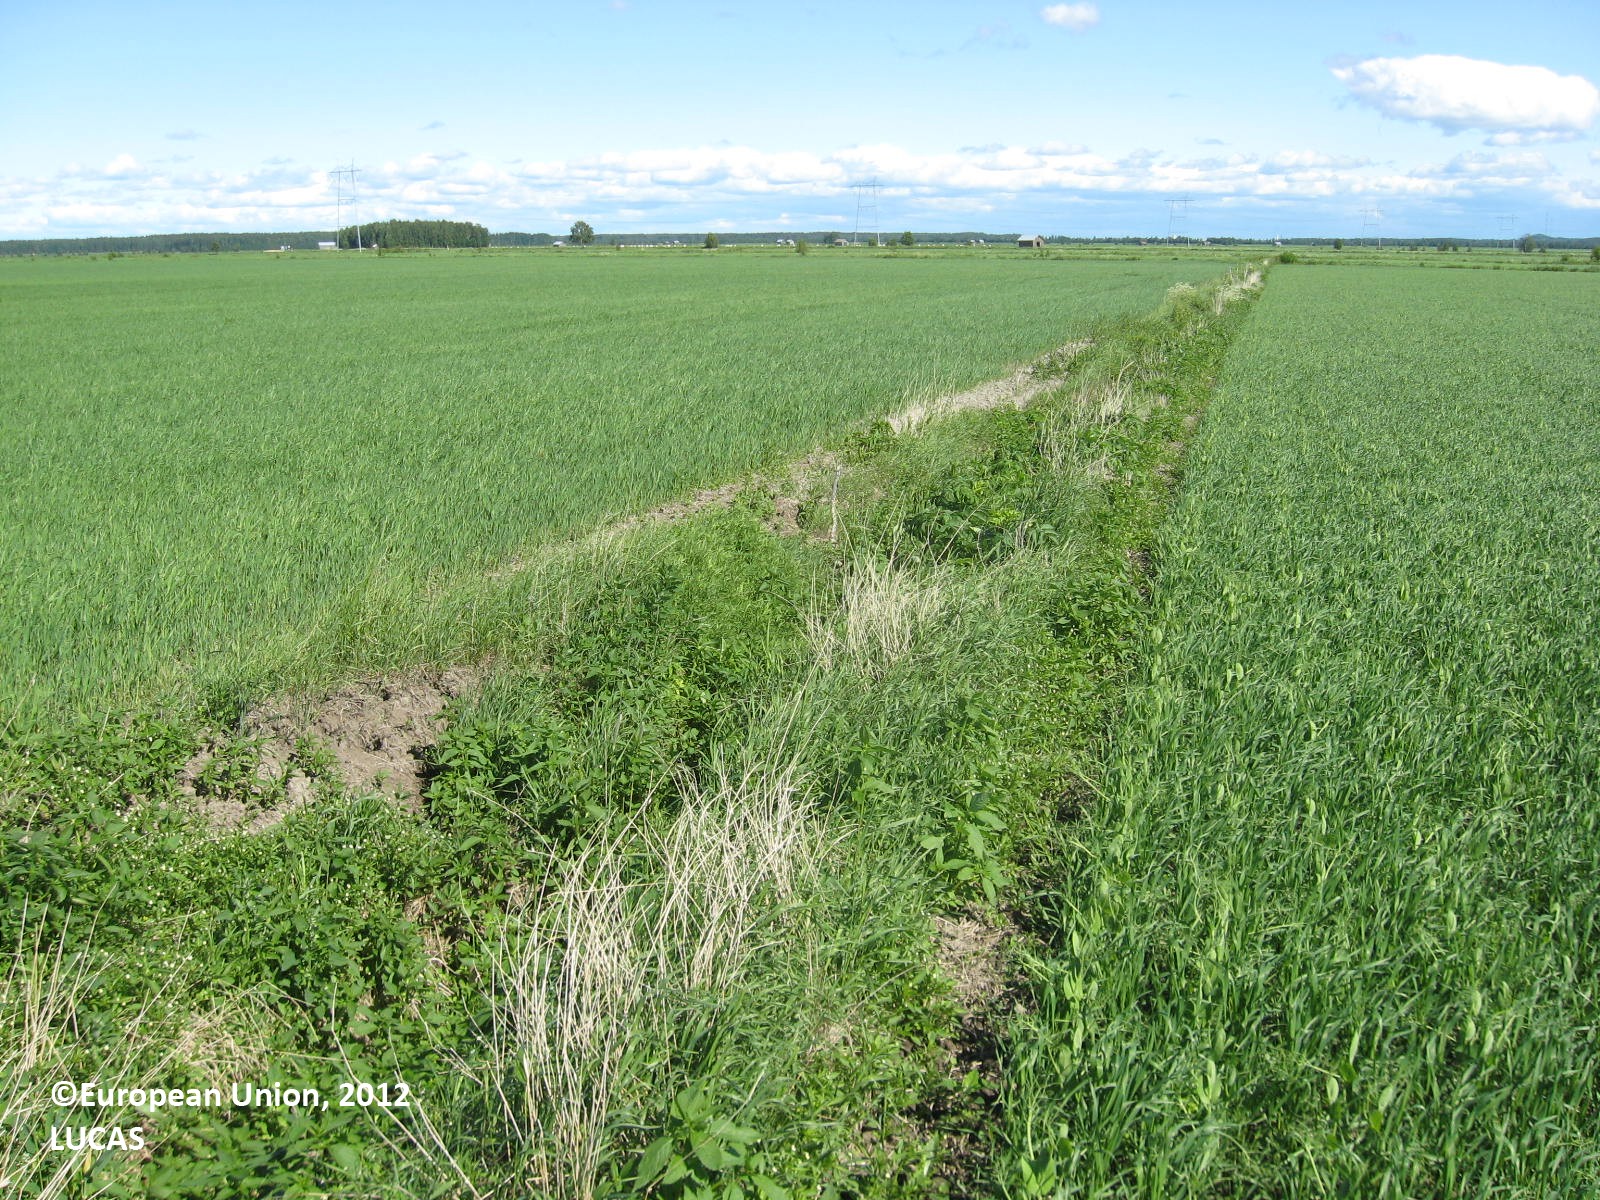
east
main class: Cropland
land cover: Temporary grasslands
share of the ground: > 75 %
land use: Agriculture (excluding fallow land and kitchen gardens)
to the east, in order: Temporary grasslands; Mixed cereals for fodder; Grass margins; Ditches and canals; Grass margins; Barley; Shruby margins; Ditches and canals; Shruby margins; Barley
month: June
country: FI
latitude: 62.8103
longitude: 22.6292
